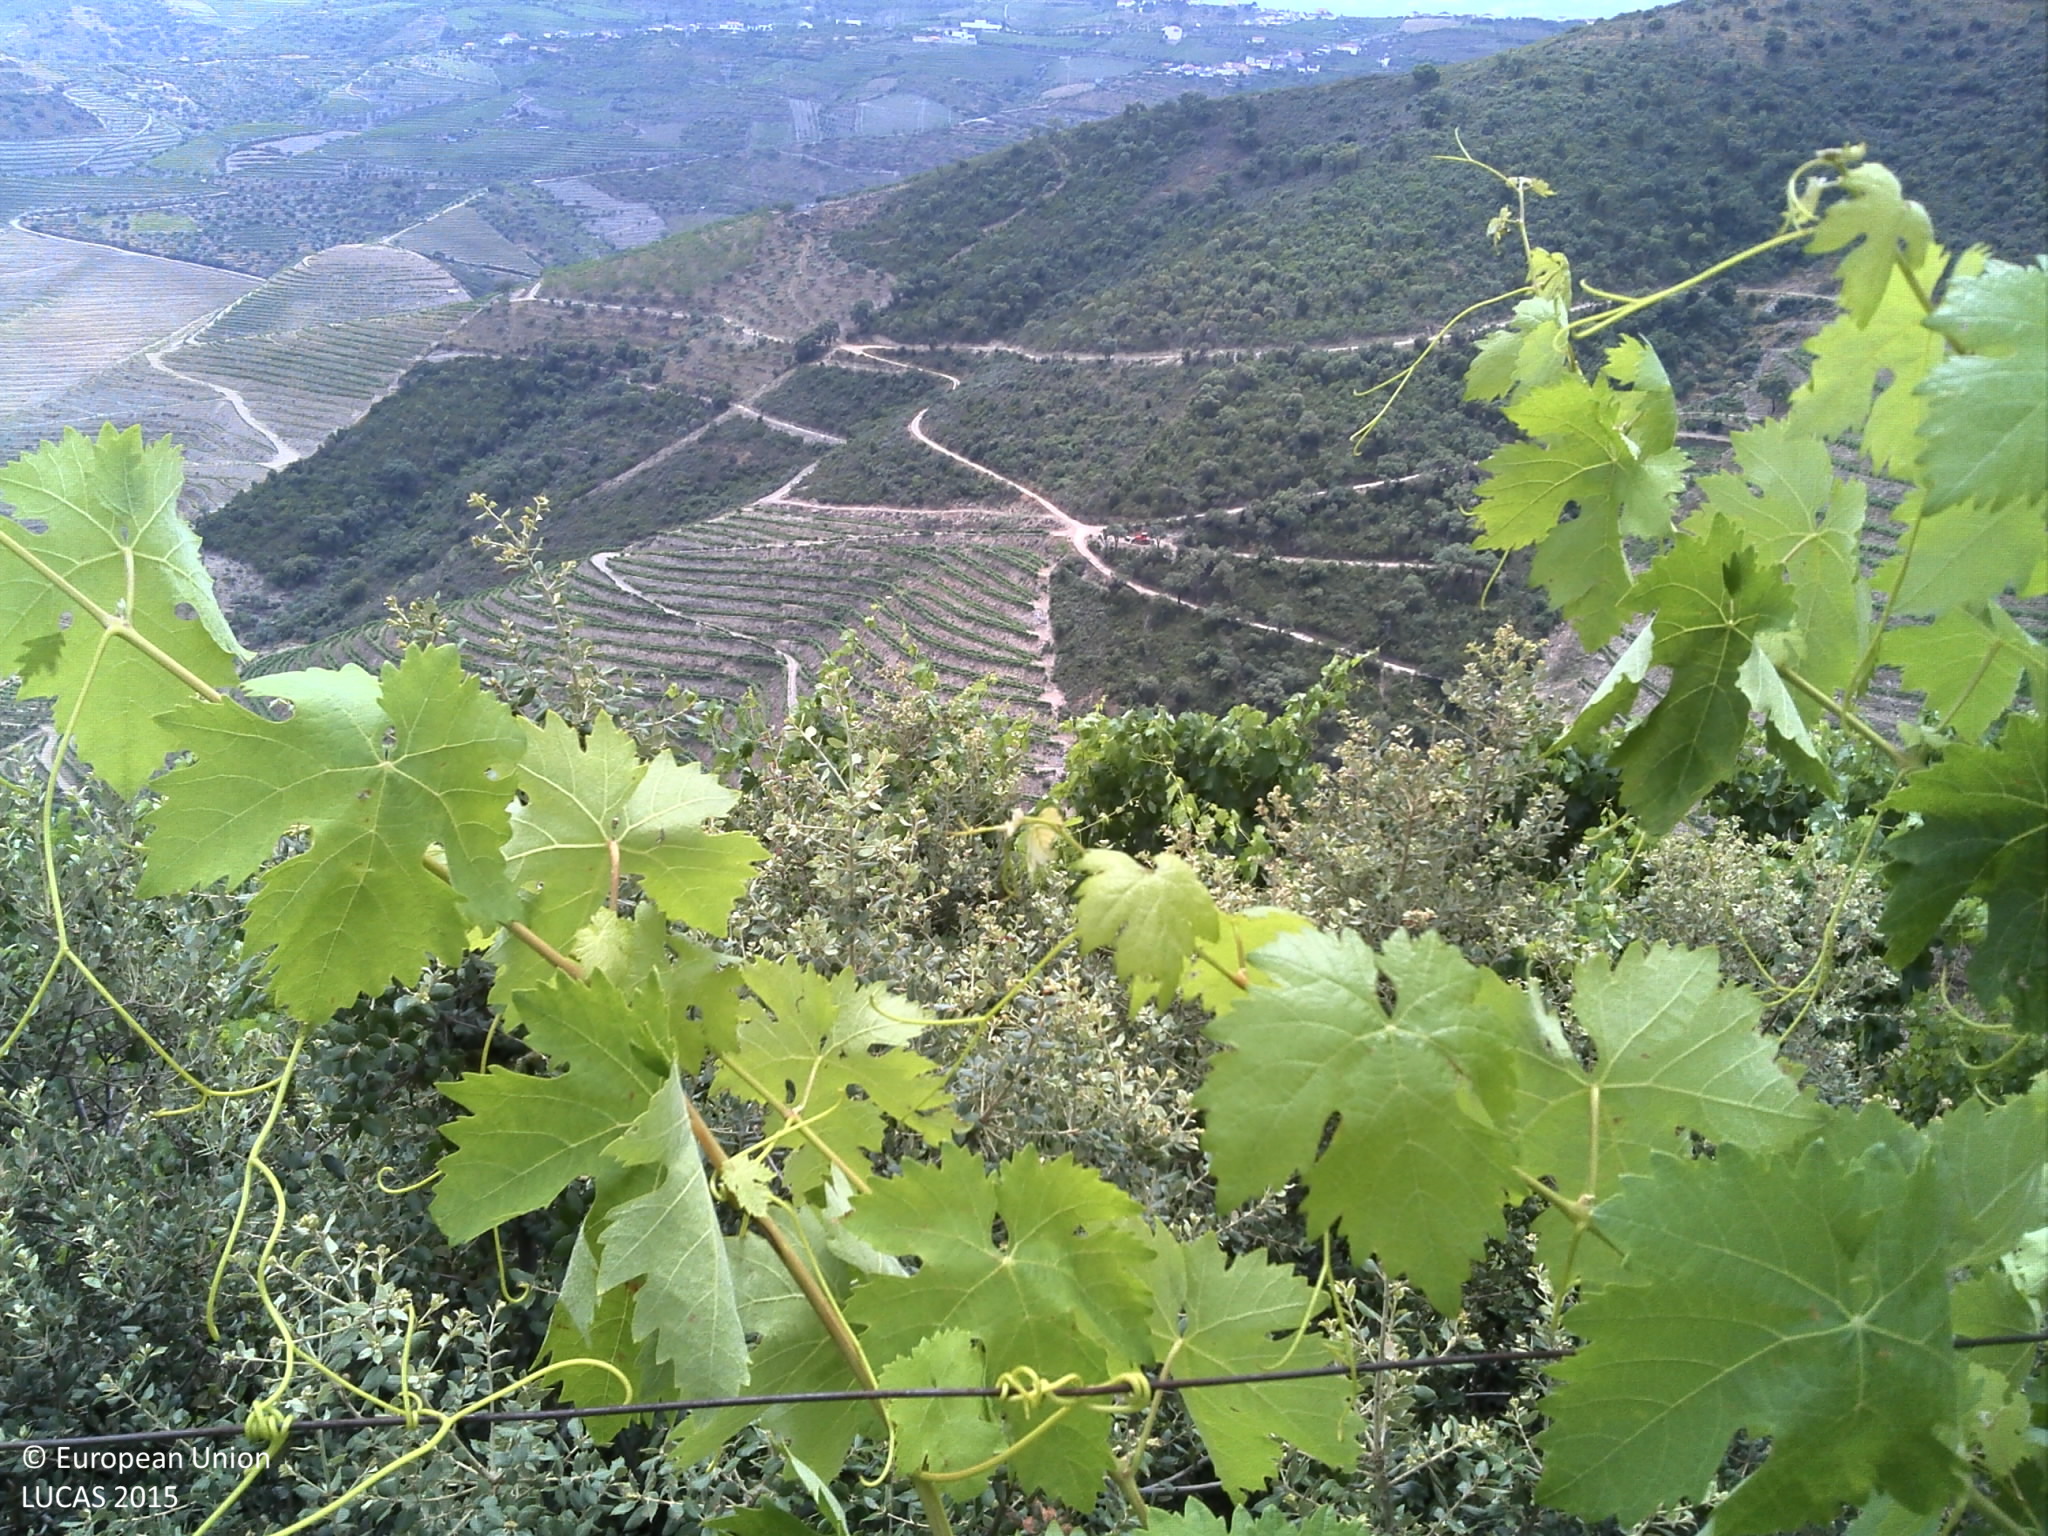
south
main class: Cropland
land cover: Vineyards
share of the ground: < 10 %
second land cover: Spontaneously vegetated surfaces
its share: 25 - 50 %
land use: Agriculture (excluding fallow land and kitchen gardens)
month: June
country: PT
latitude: 41.1201
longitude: -7.3758
